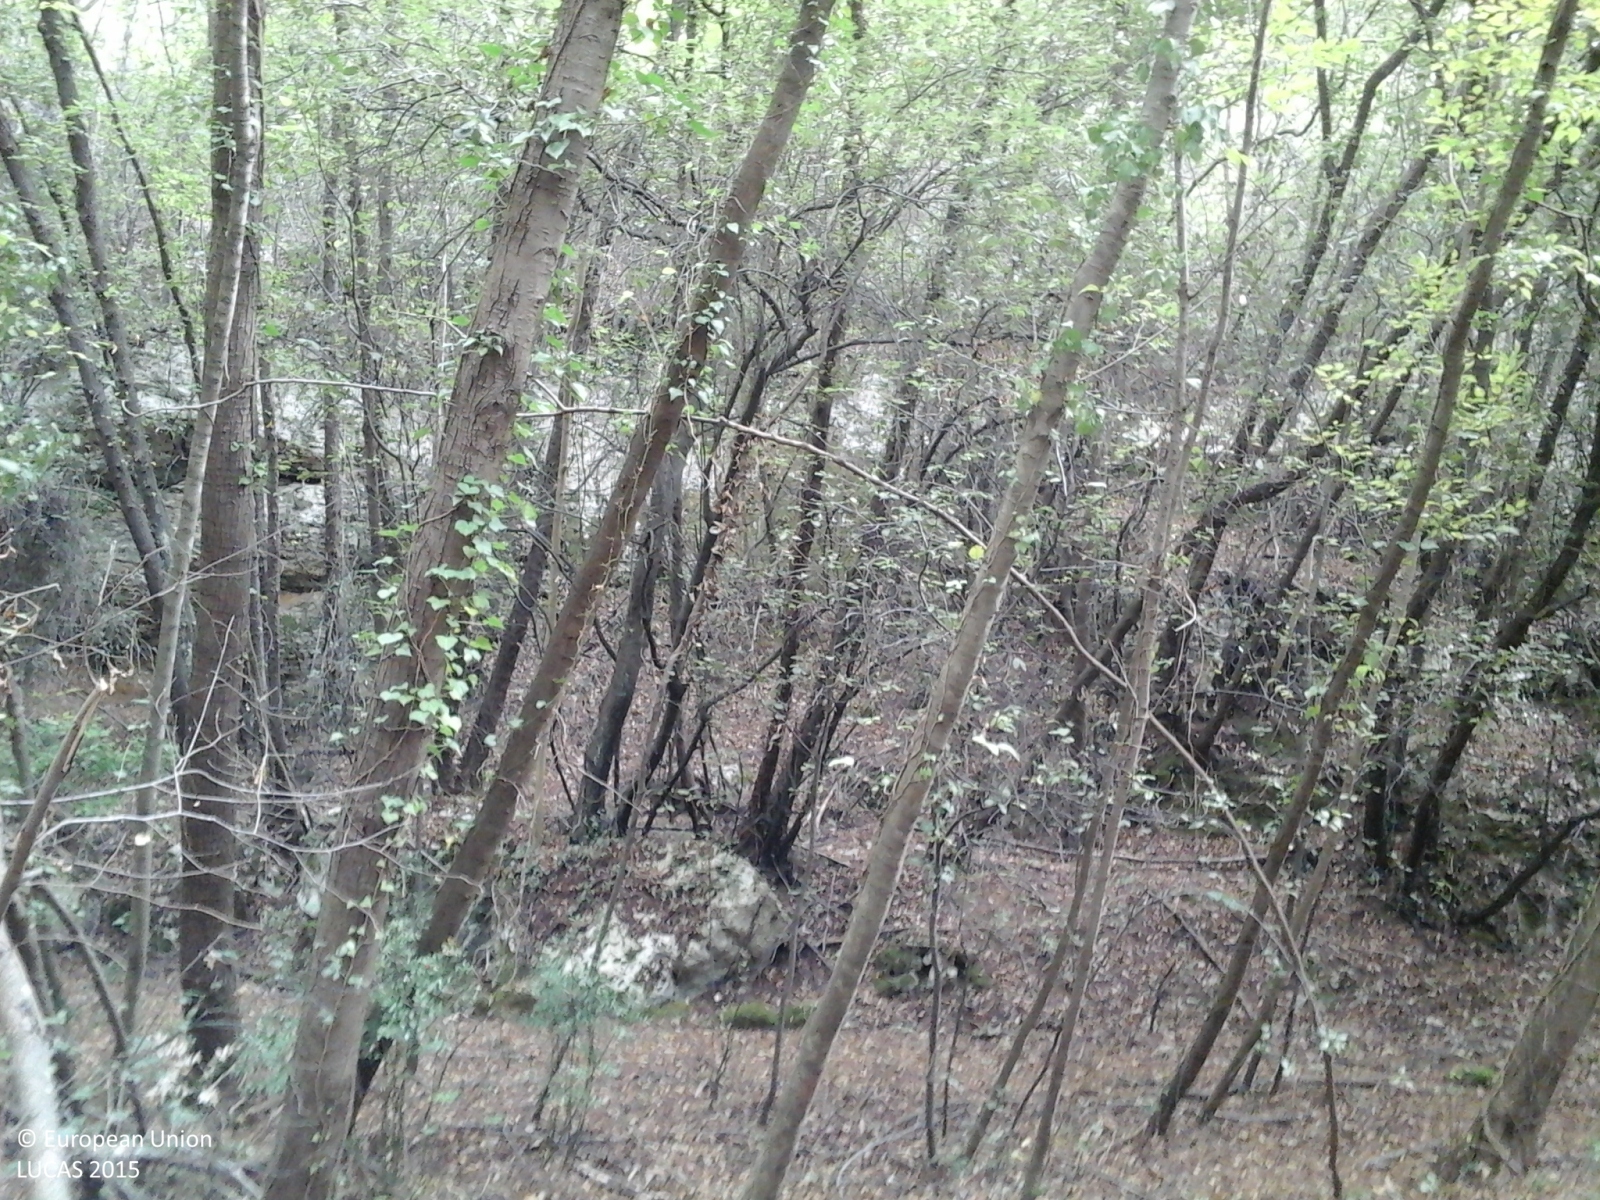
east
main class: Woodland
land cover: Broadleaved woodland
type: thermophilous deciduous forest
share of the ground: > 75 %
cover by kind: broadleaved forest trees 100 %
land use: Semi-natural and natural areas not in use
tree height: > 5 m
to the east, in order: Broadleaved woodland; Rock outcrops; Broadleaved woodland; Rock outcrops; Broadleaved woodland; Shrubland with sparse tree cover; Broadleaved woodland
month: September
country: IT
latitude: 44.1930
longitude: 8.3398
